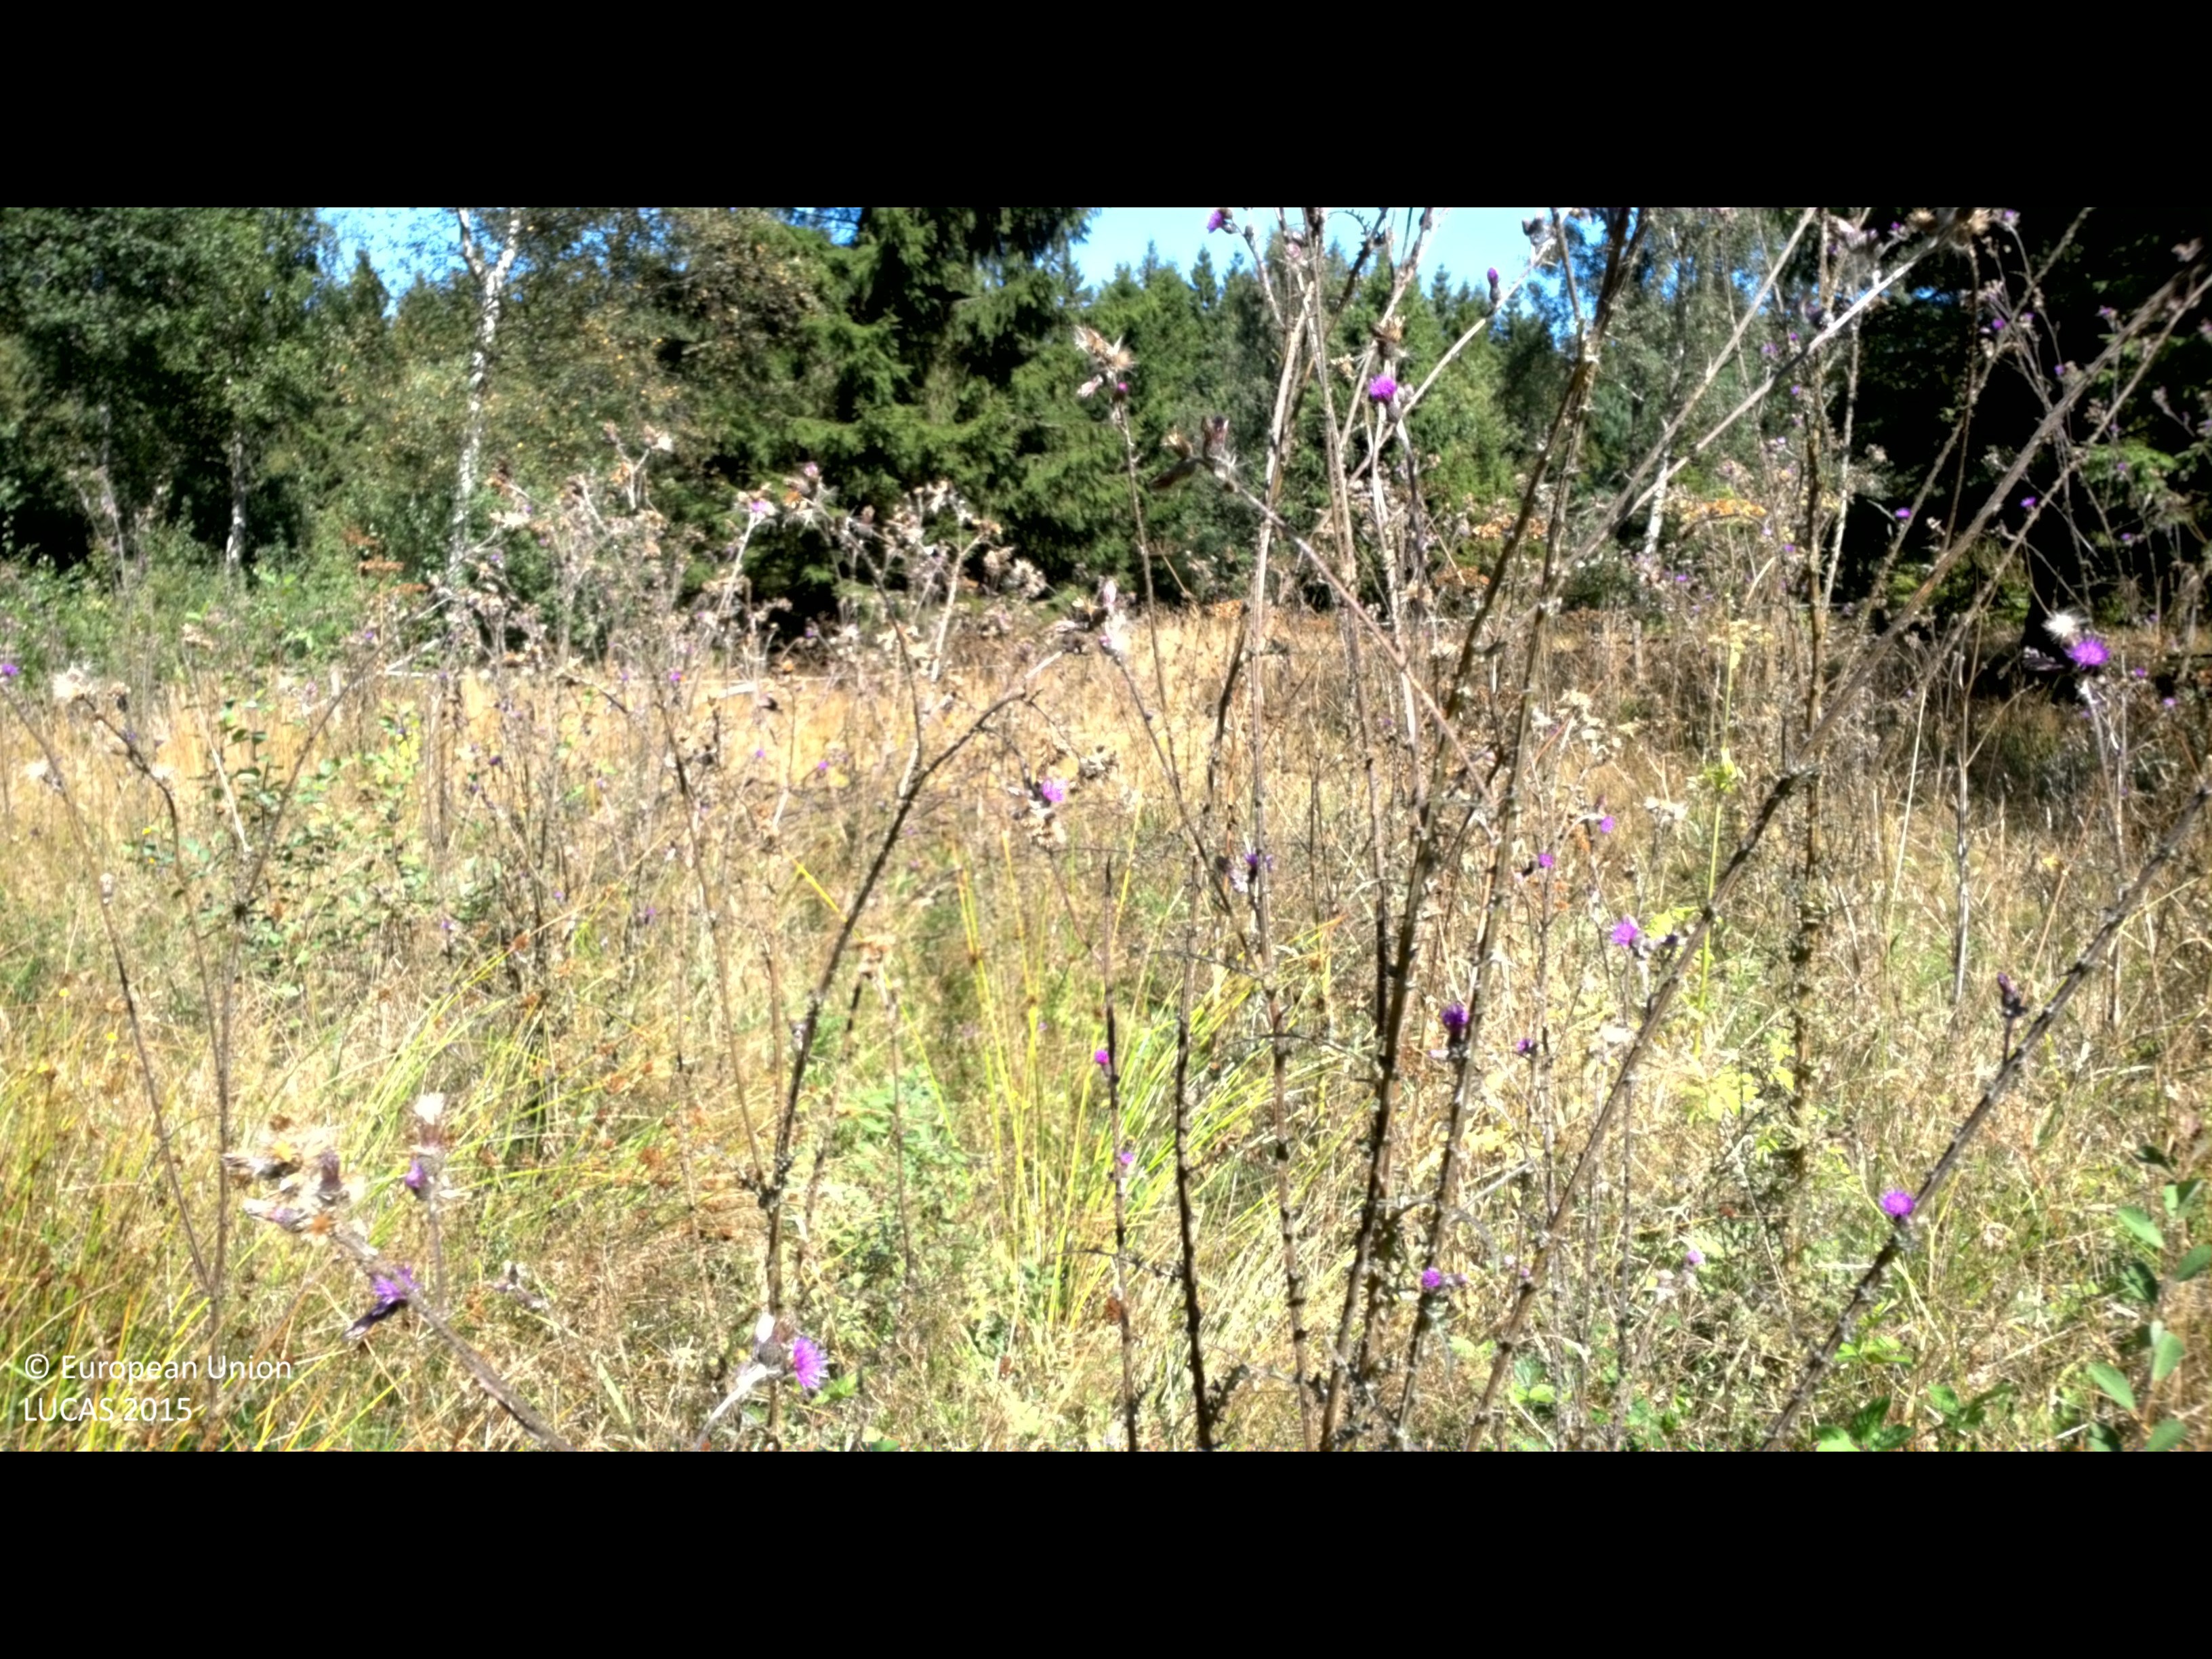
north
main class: Grassland
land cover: Grassland without tree/shrub cover
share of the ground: > 75 %
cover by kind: herbaceous plants 100 %
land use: Semi-natural and natural areas not in use
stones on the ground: < 10 %
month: August
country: SE
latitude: 56.1613
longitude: 15.8778
